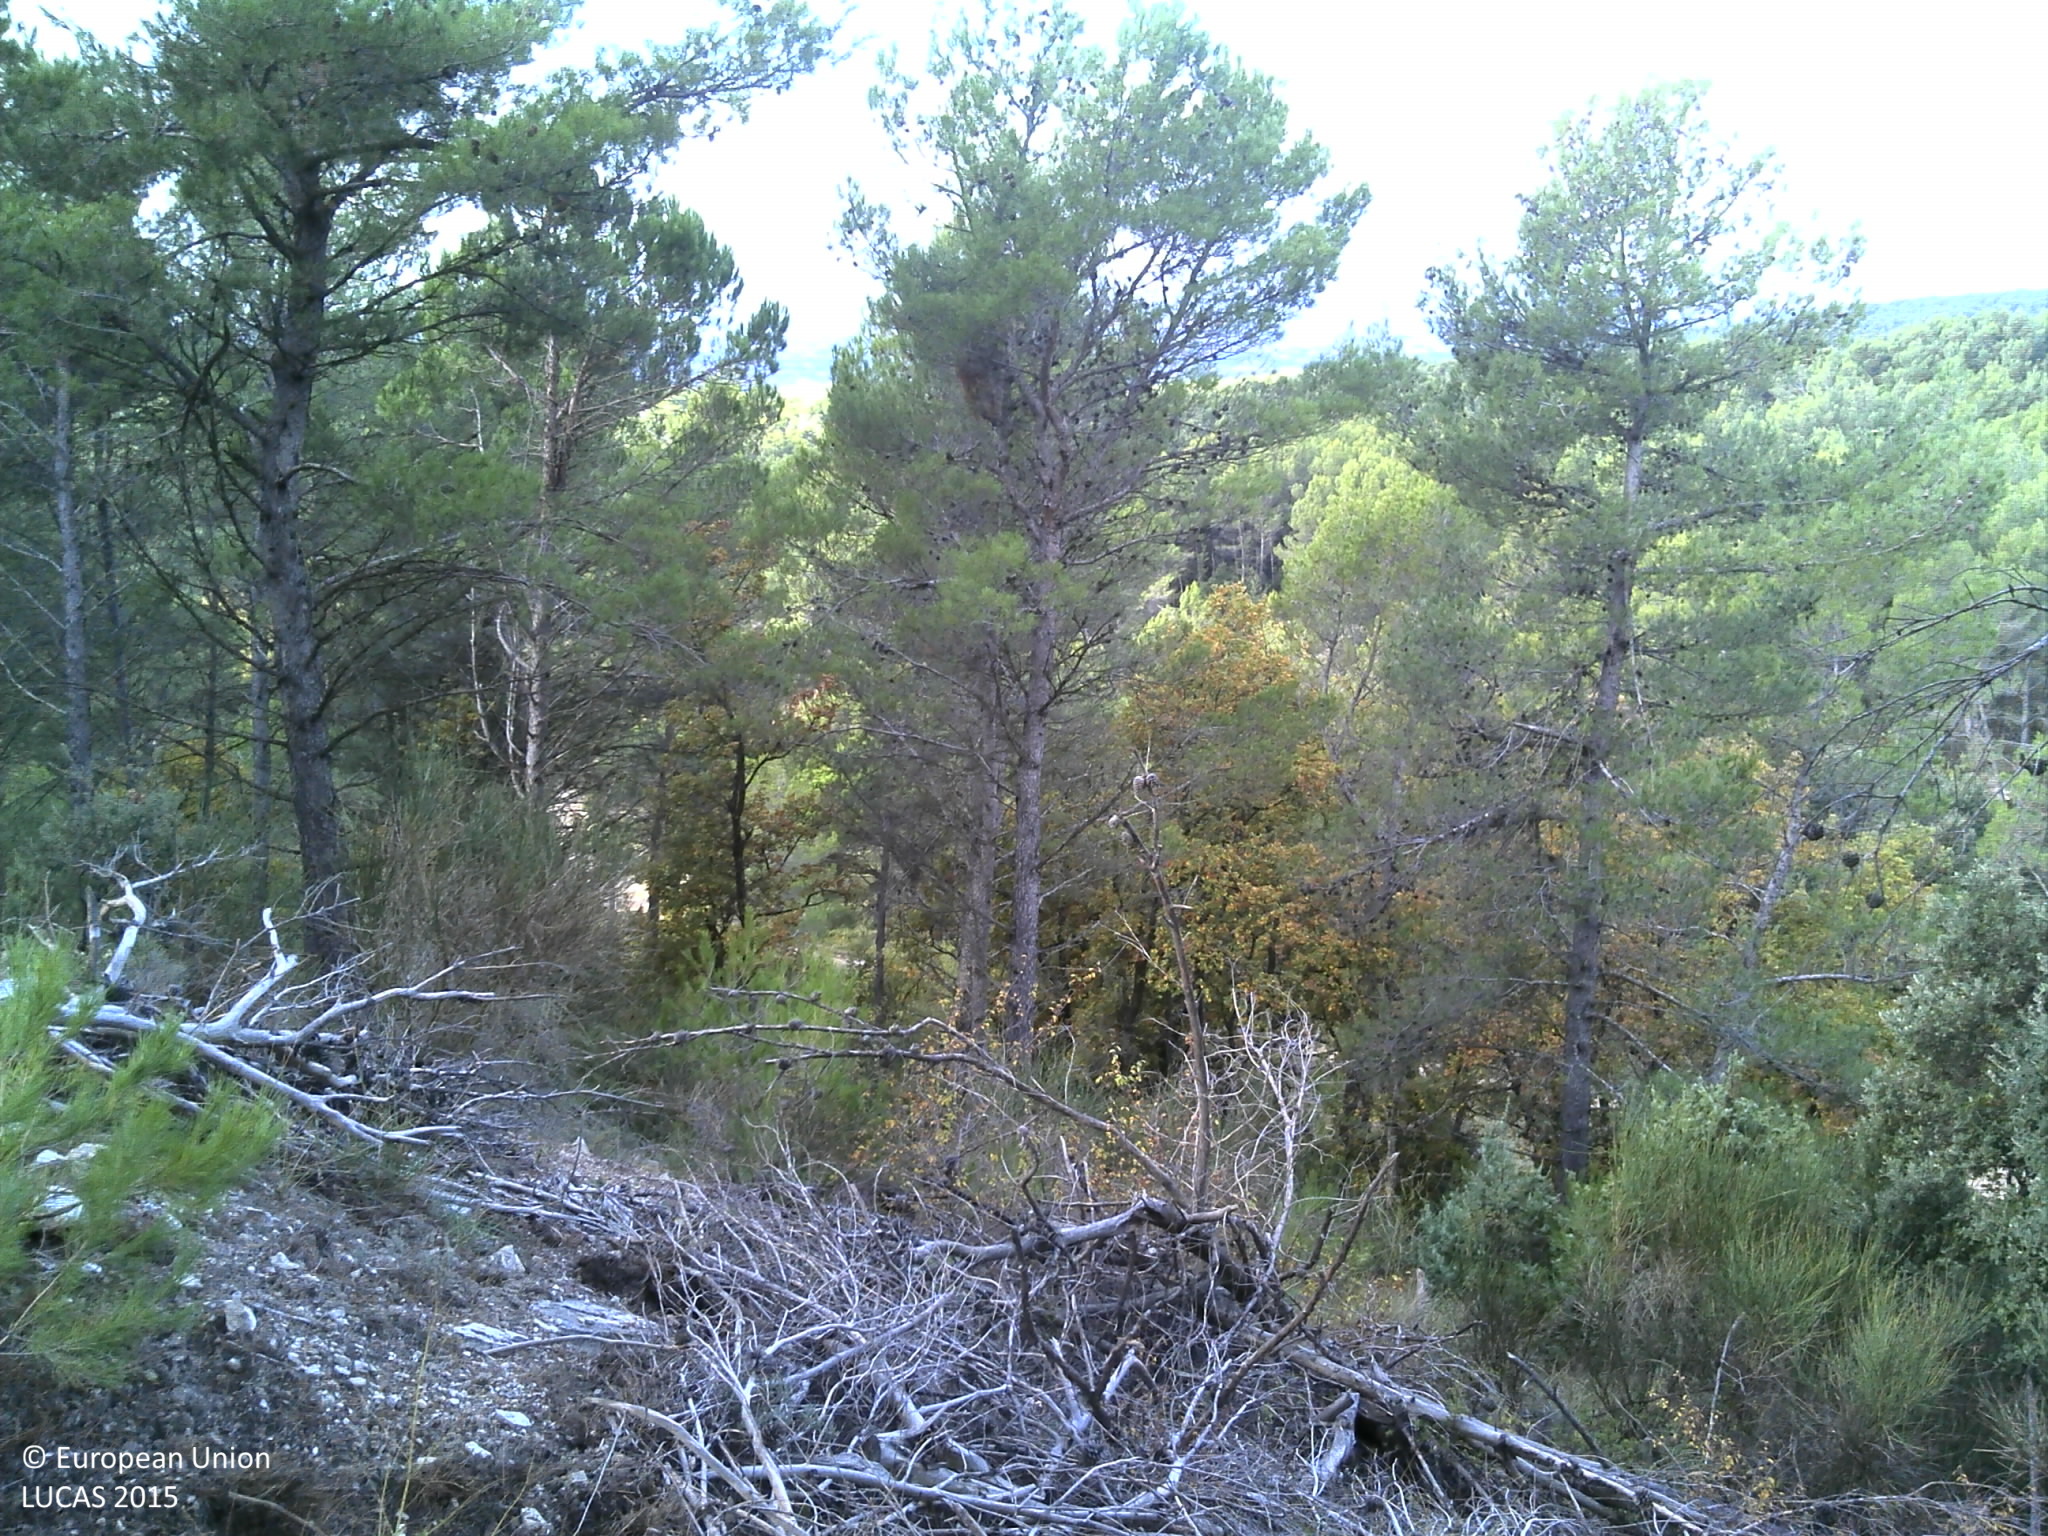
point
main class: Woodland
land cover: Pine dominated mixed woodland
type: coniferous forest of the mediterranean region
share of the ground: 50 - 75 %
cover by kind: coniferous forest trees 40 %, herbaceous plants 35 %, broadleaved forest trees 25 %
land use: Forestry
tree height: > 5 m
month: October
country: FR
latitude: 43.9631
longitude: 5.0856
